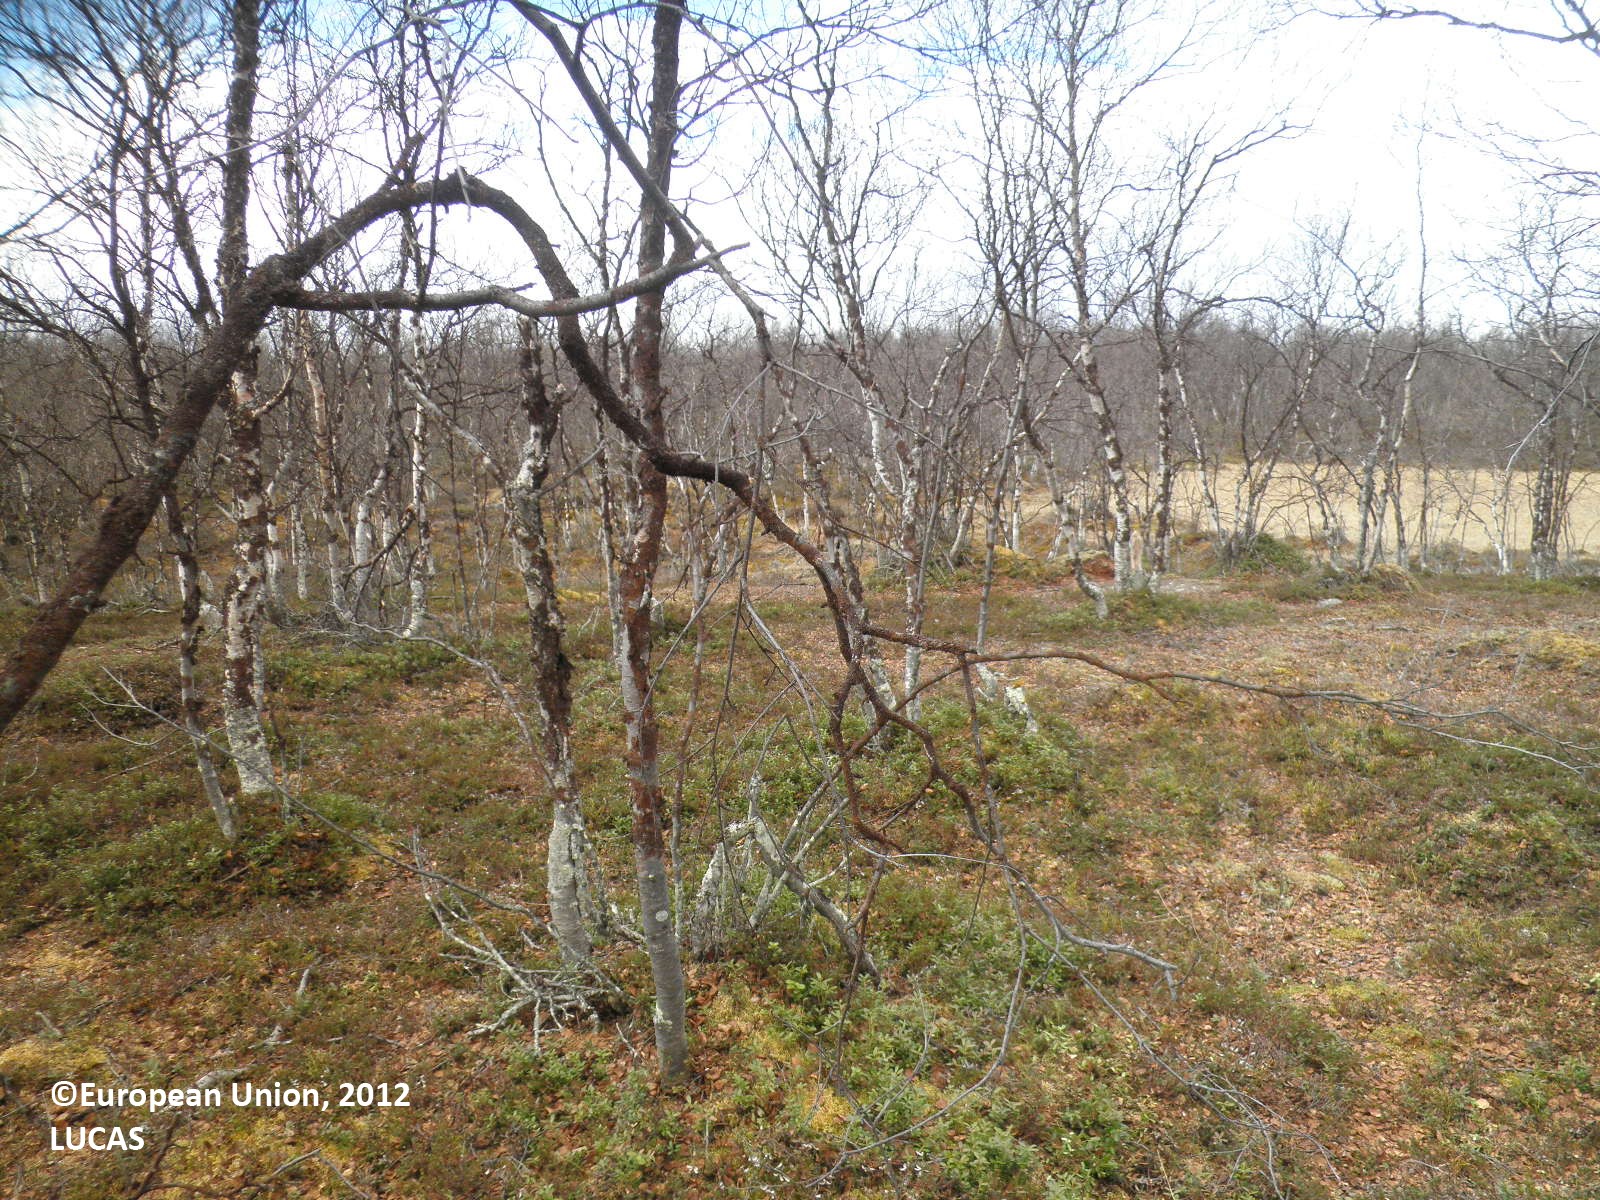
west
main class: Woodland
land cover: Broadleaved woodland
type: boreal forest
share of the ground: 50 - 75 %
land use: Forestry
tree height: > 5 m
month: May
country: FI
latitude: 69.3782
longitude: 27.2293
